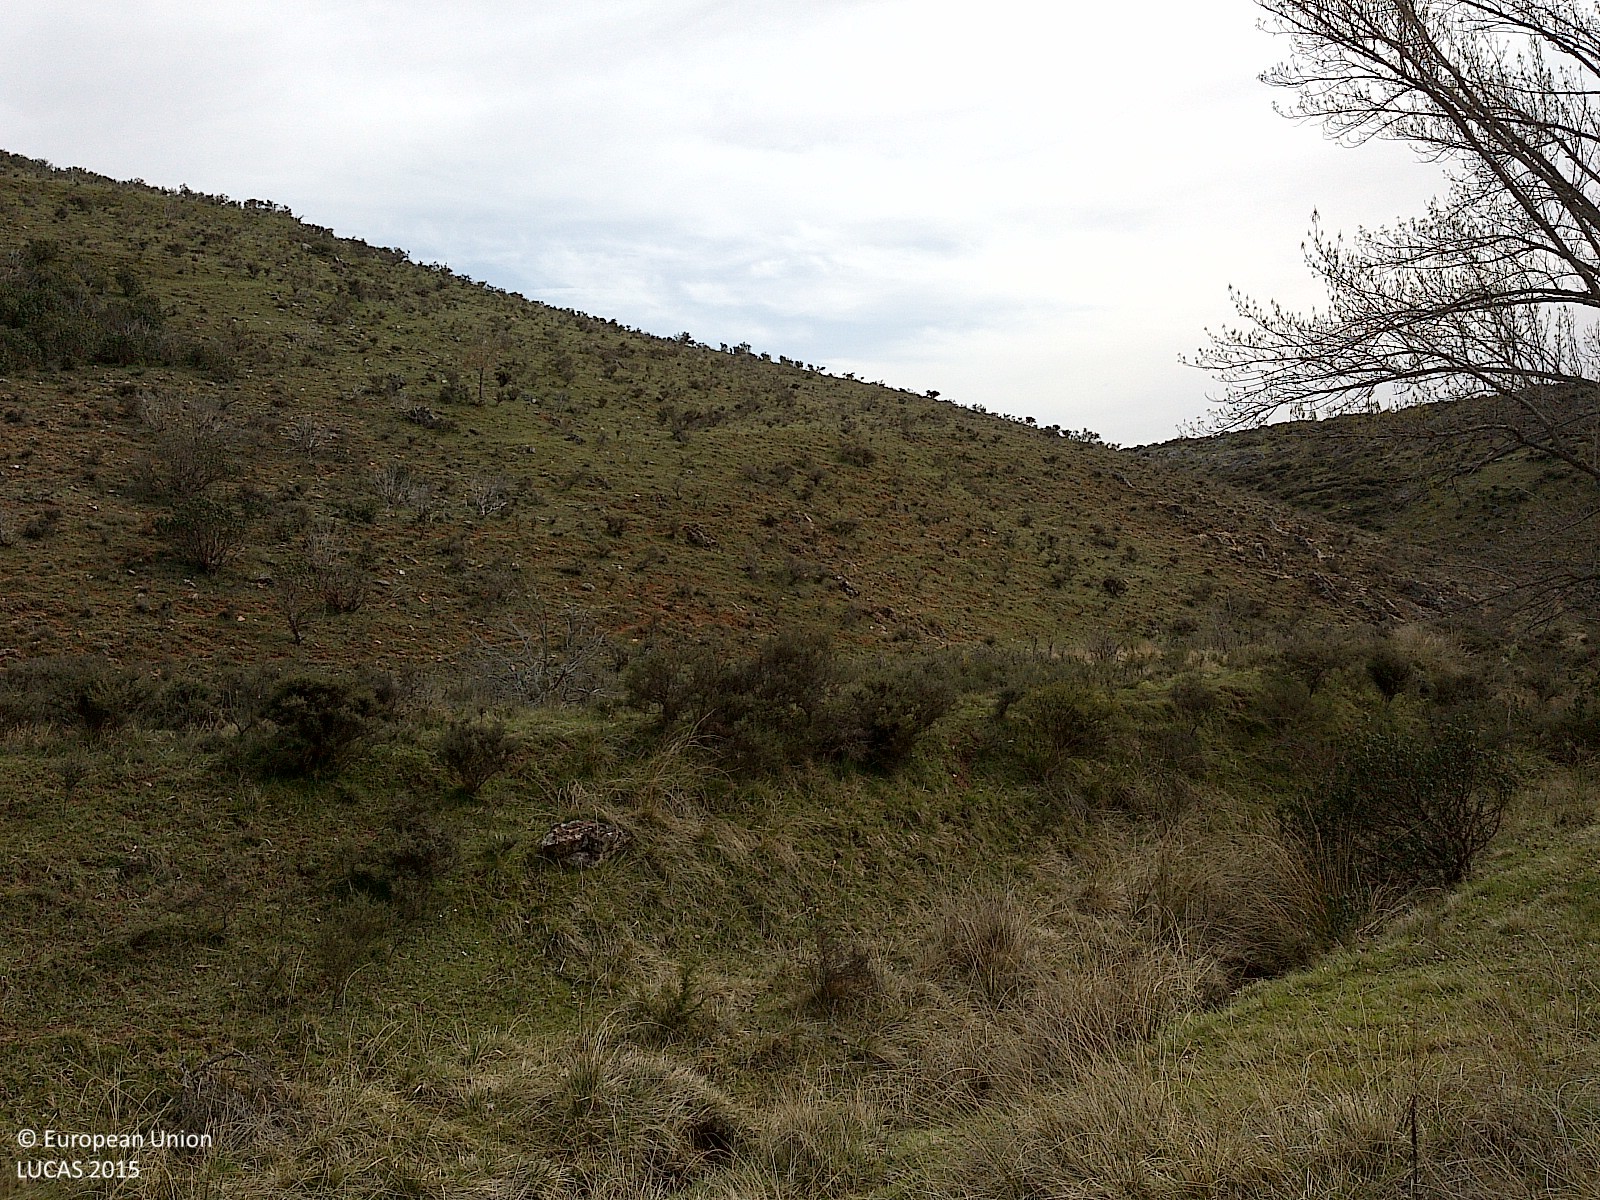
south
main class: Shrubland
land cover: Shrubland without tree cover
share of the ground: 25 - 50 %
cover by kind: herbaceous plants 55 %, shrubs 45 %
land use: Agriculture (excluding fallow land and kitchen gardens)
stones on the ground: < 10 %
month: April
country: ES
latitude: 42.0816
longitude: -3.3129
